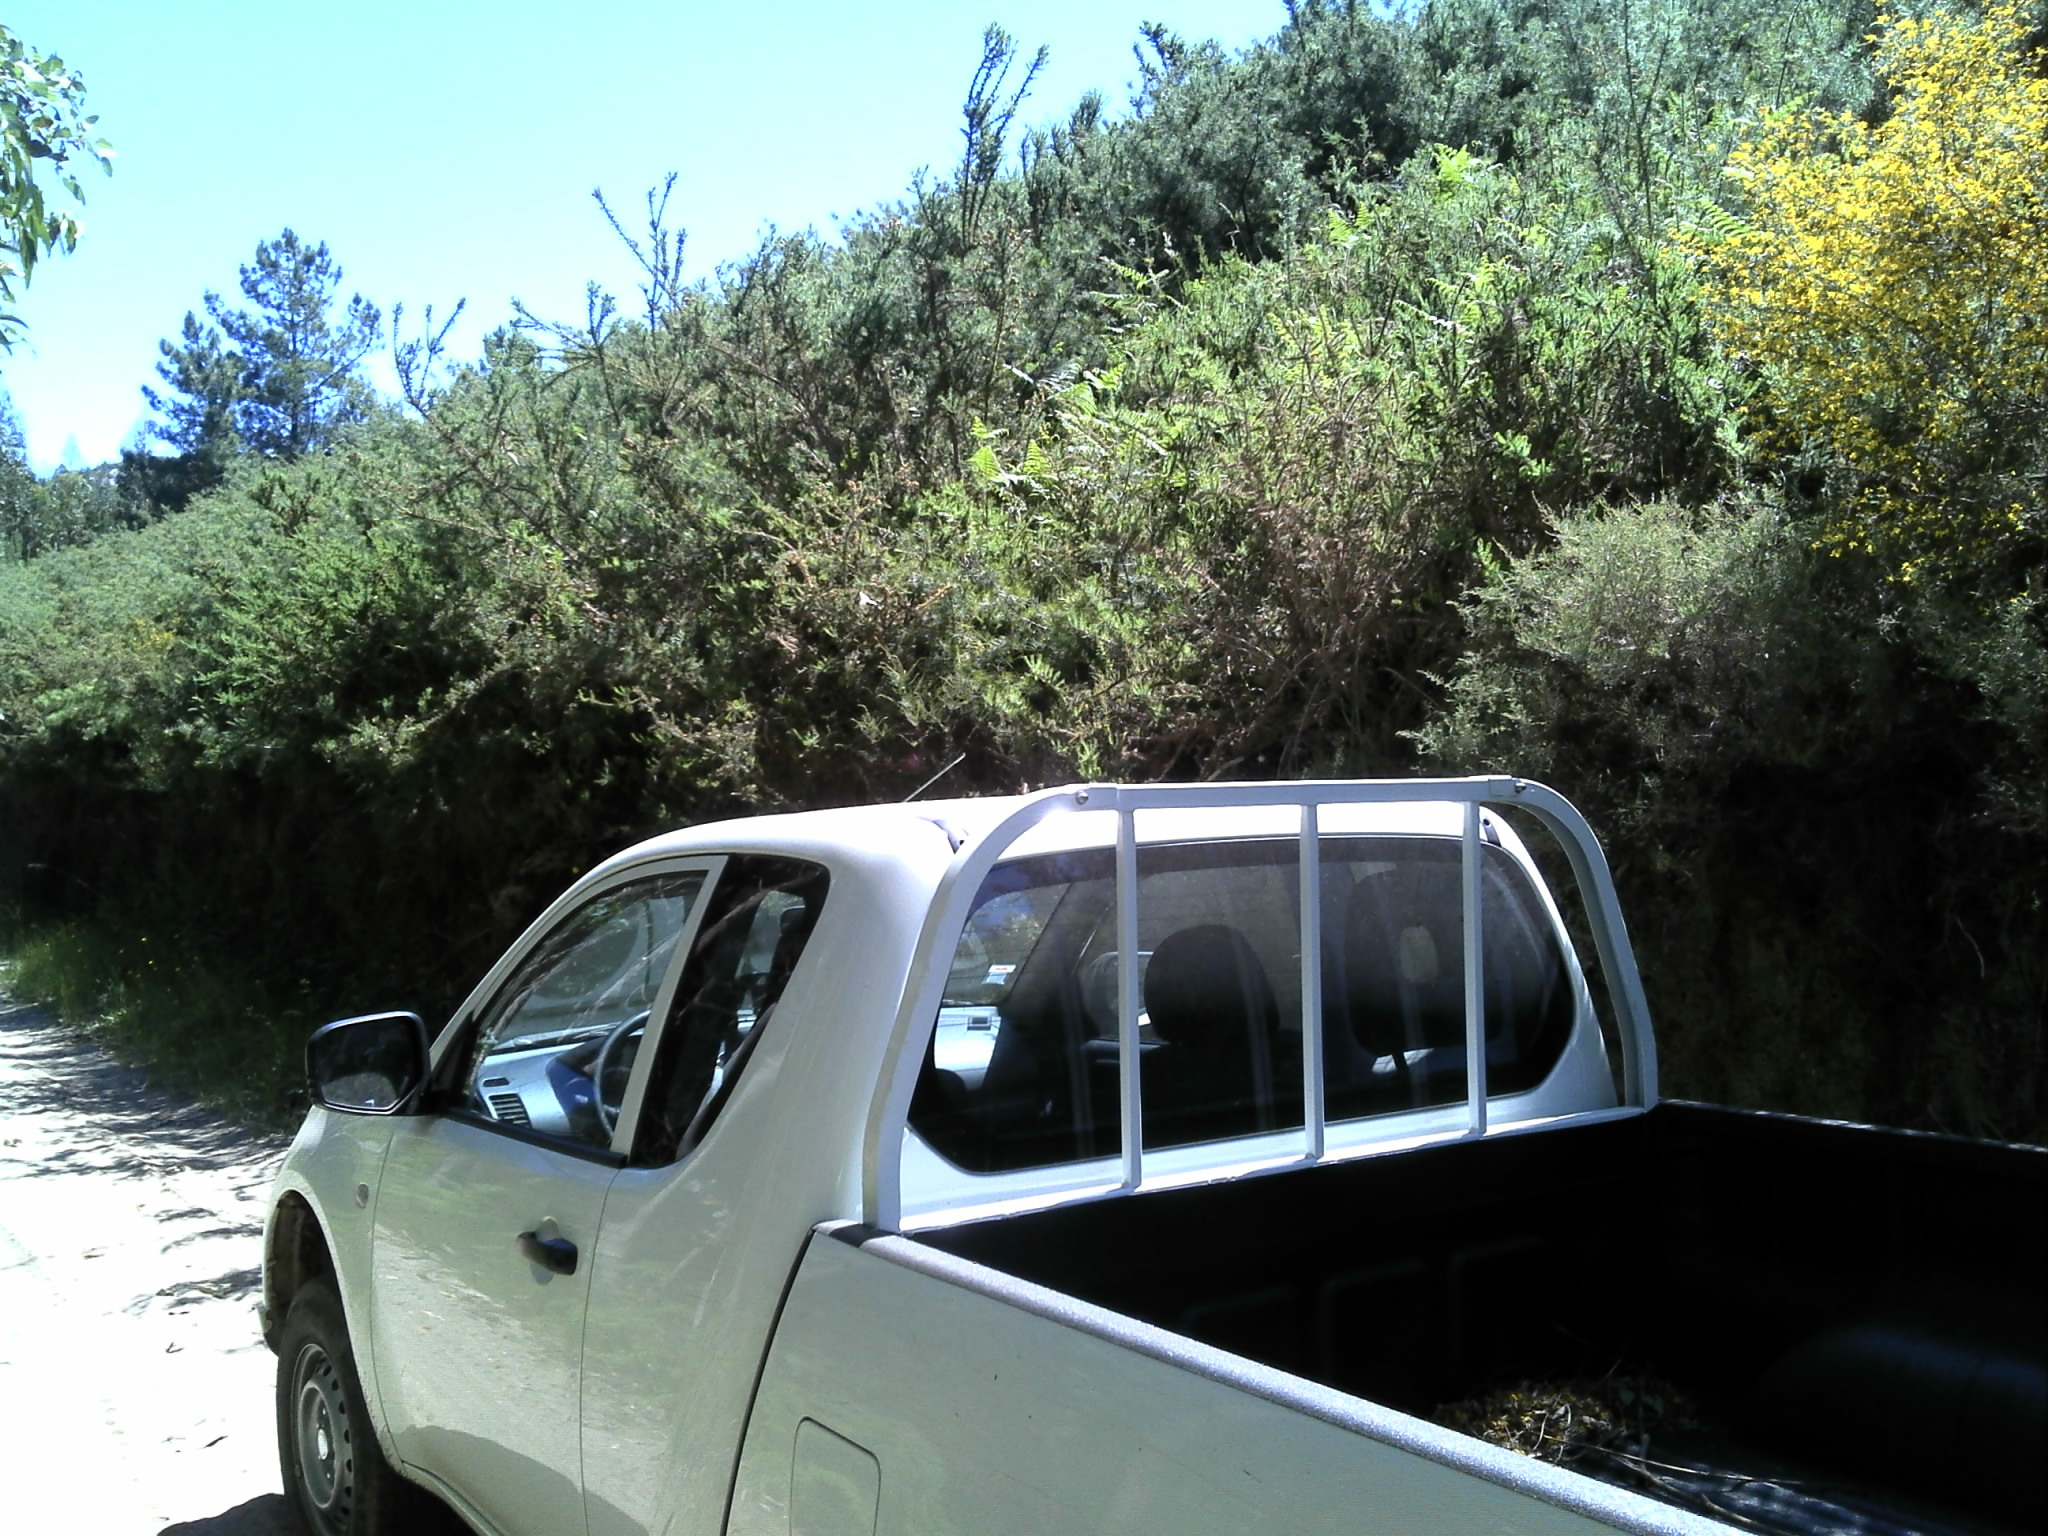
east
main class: Woodland
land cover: Broadleaved woodland
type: exotic forest
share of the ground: > 75 %
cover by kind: broadleaved forest trees 80 %, shrubs 15 %, herbaceous plants 5 %
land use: Forestry
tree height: > 5 m
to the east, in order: Broadleaved woodland; Tracks; Shrubland without tree cover; Tracks; Shrubland with sparse tree cover
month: May
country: PT
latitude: 41.8499
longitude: -8.7286
